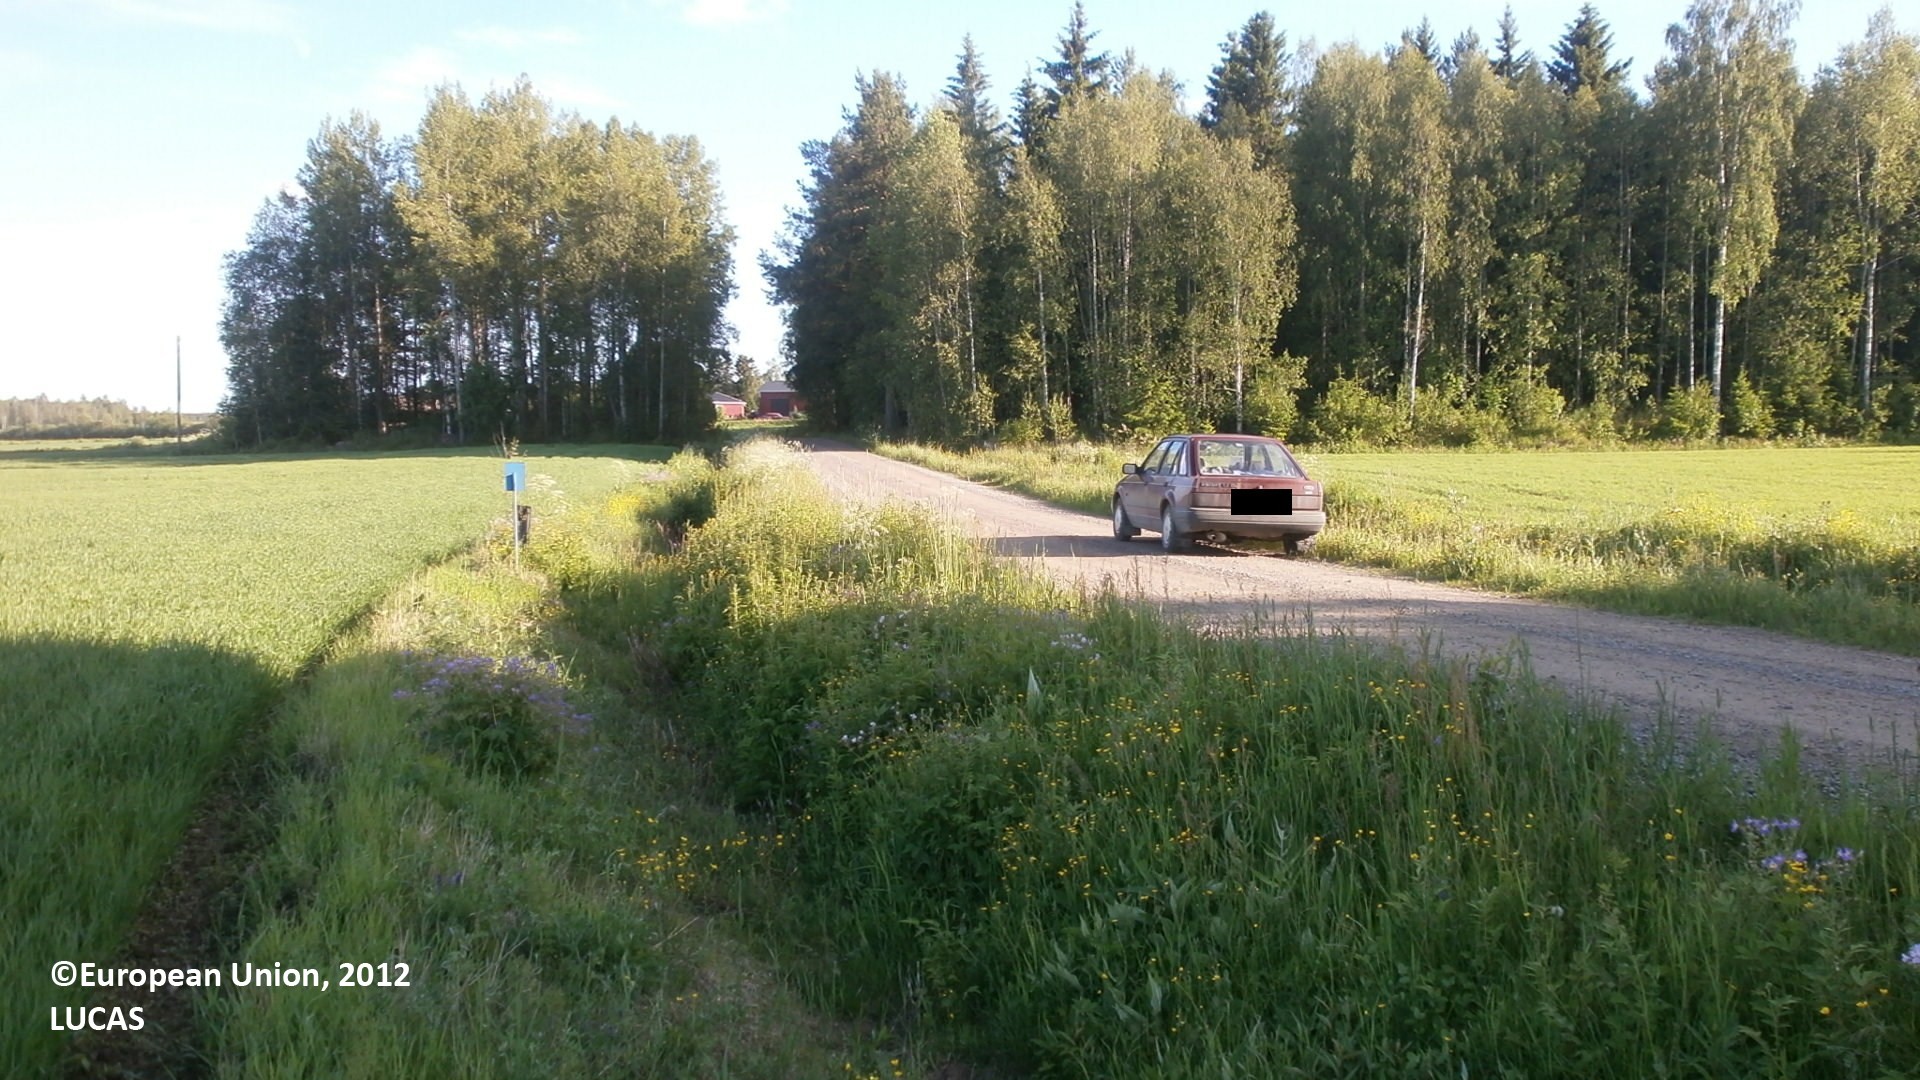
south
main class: Cropland
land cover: Barley
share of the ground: 50 - 75 %
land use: Agriculture (excluding fallow land and kitchen gardens)
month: June
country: FI
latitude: 64.3960
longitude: 25.0344
